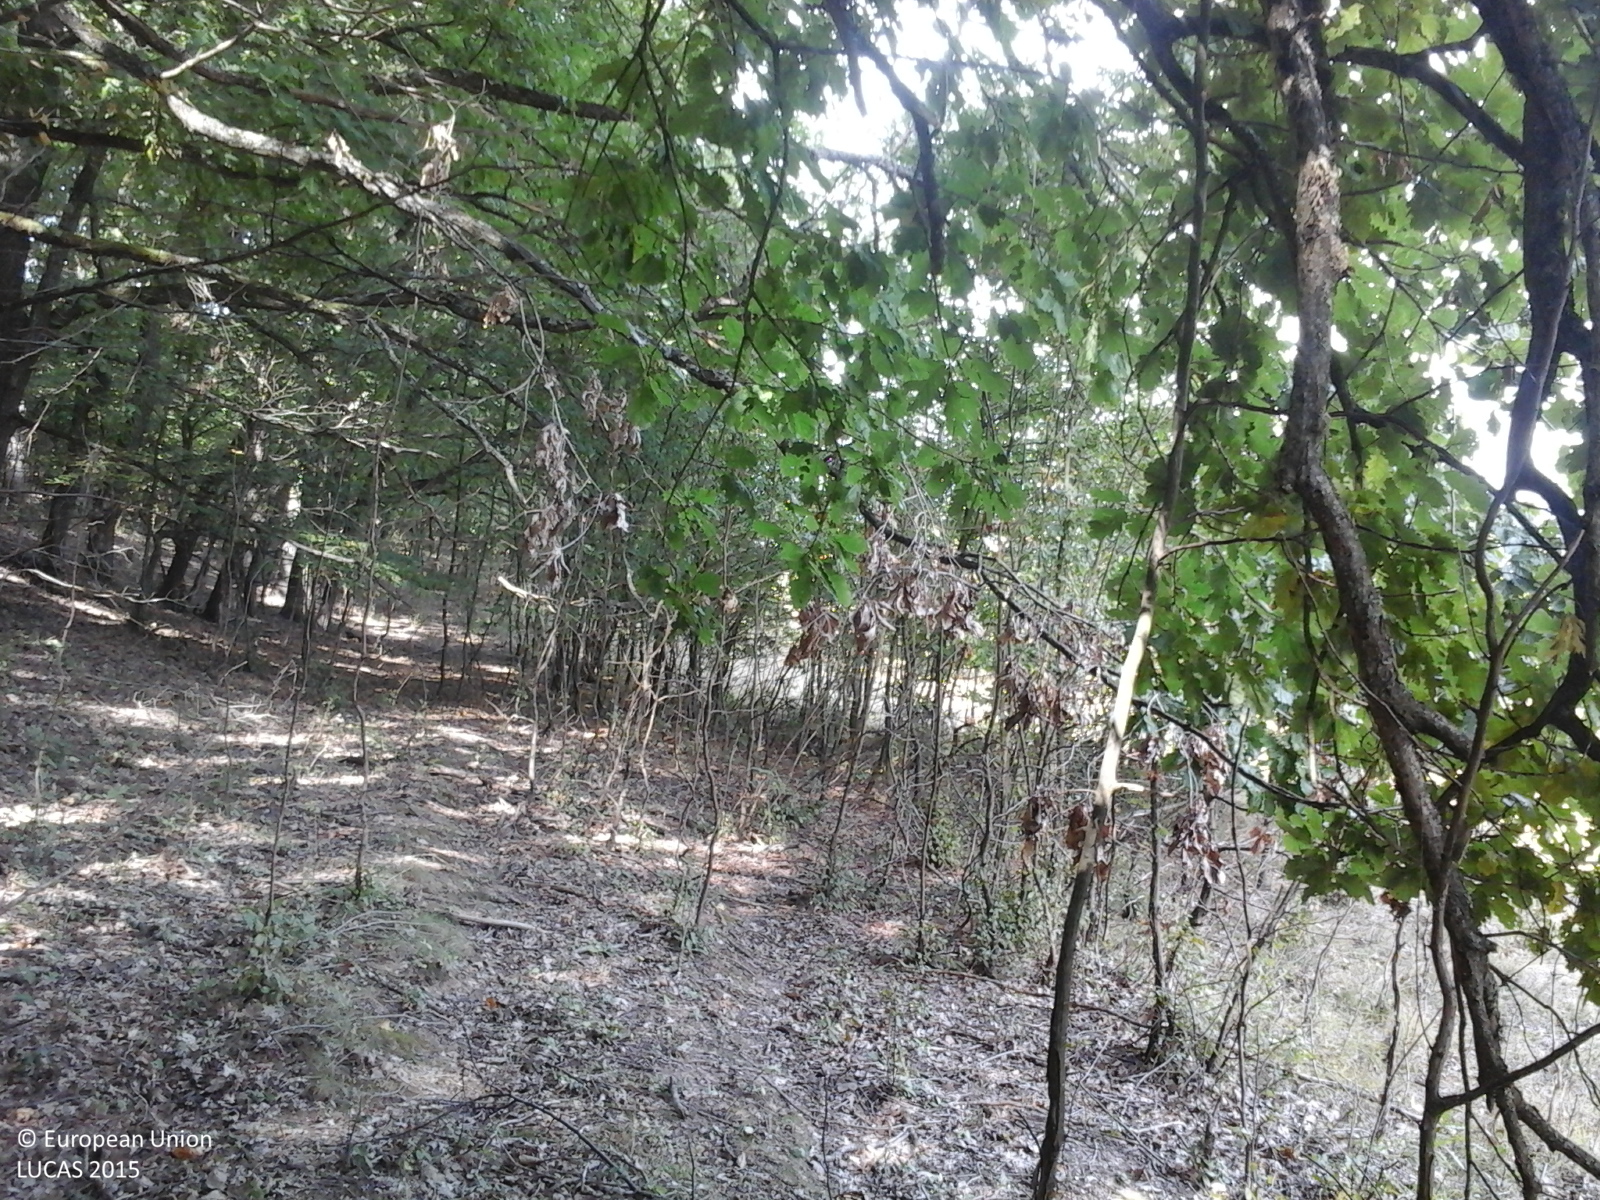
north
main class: Woodland
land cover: Broadleaved woodland
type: mesophytic deciduous forest
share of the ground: > 75 %
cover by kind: broadleaved forest trees 100 %
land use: Forestry
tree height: > 5 m
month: September
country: RO
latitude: 46.9670
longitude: 23.2220
